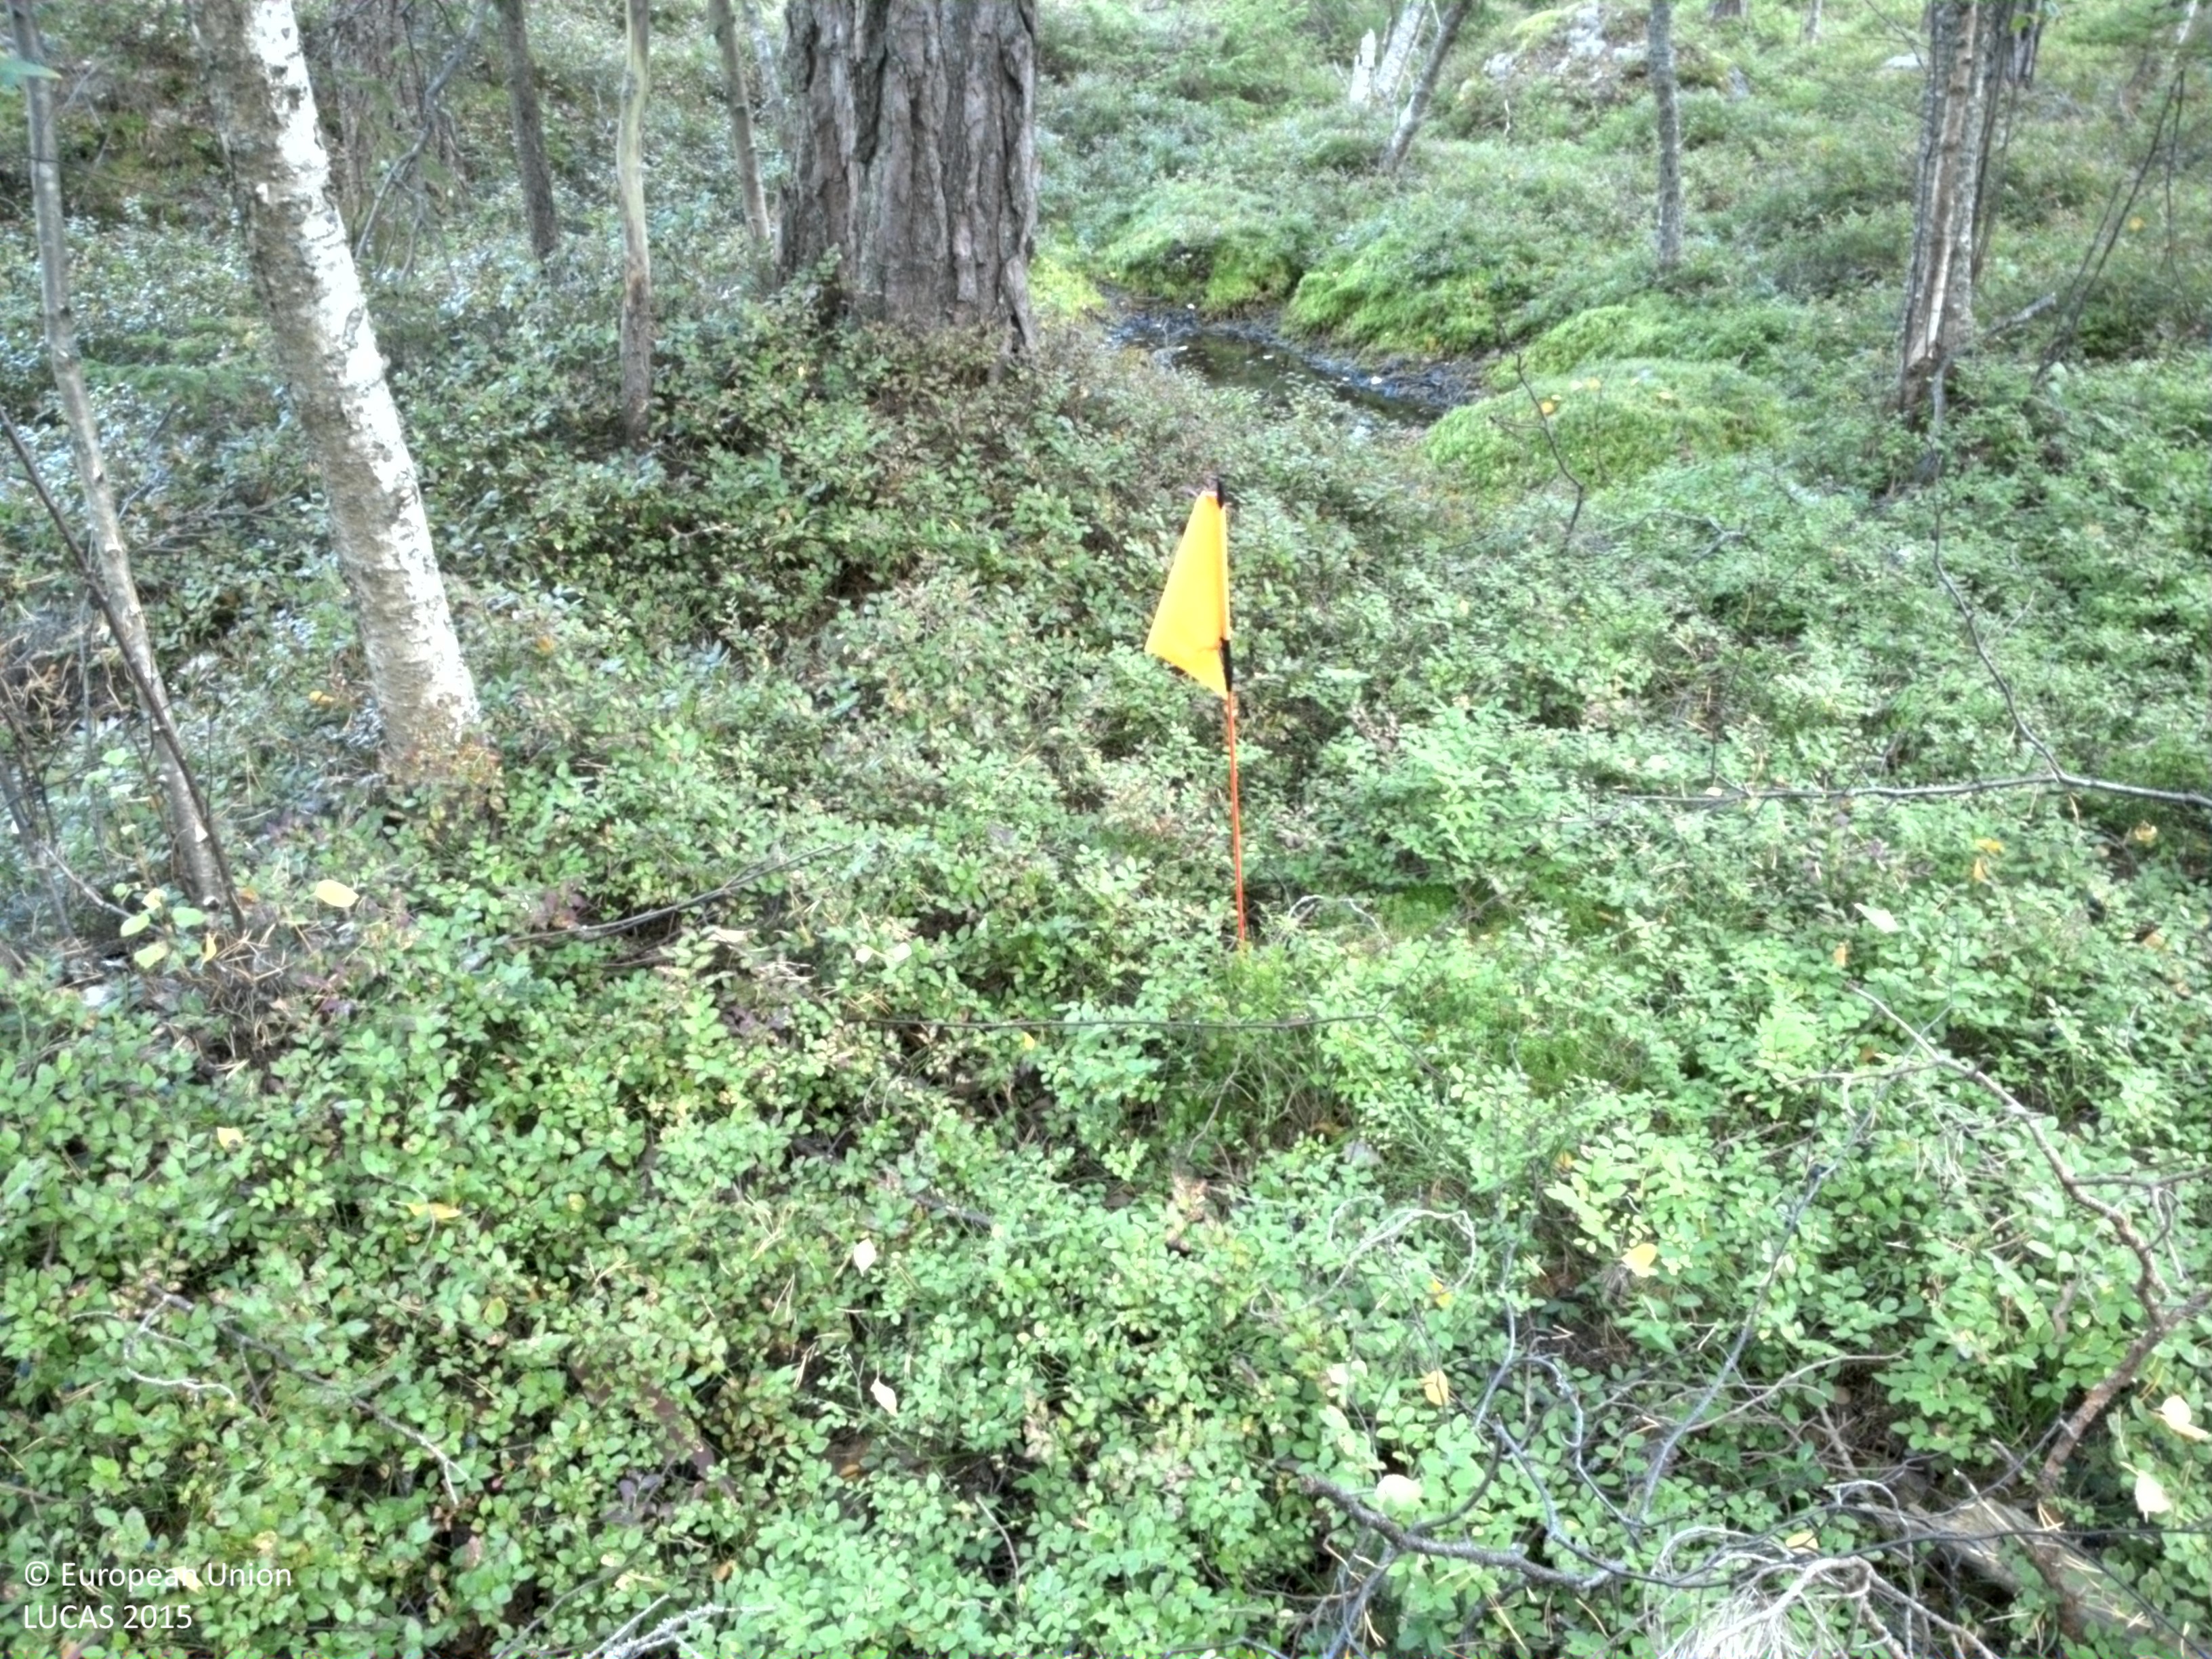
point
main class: Woodland
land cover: Pine dominated coniferous woodland
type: boreal forest
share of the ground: 50 - 75 %
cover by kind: coniferous forest trees 60 %, shrubs 25 %, lichens and mosses 15 %
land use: Forestry
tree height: > 5 m
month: September
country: SE
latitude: 59.3581
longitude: 18.5678
